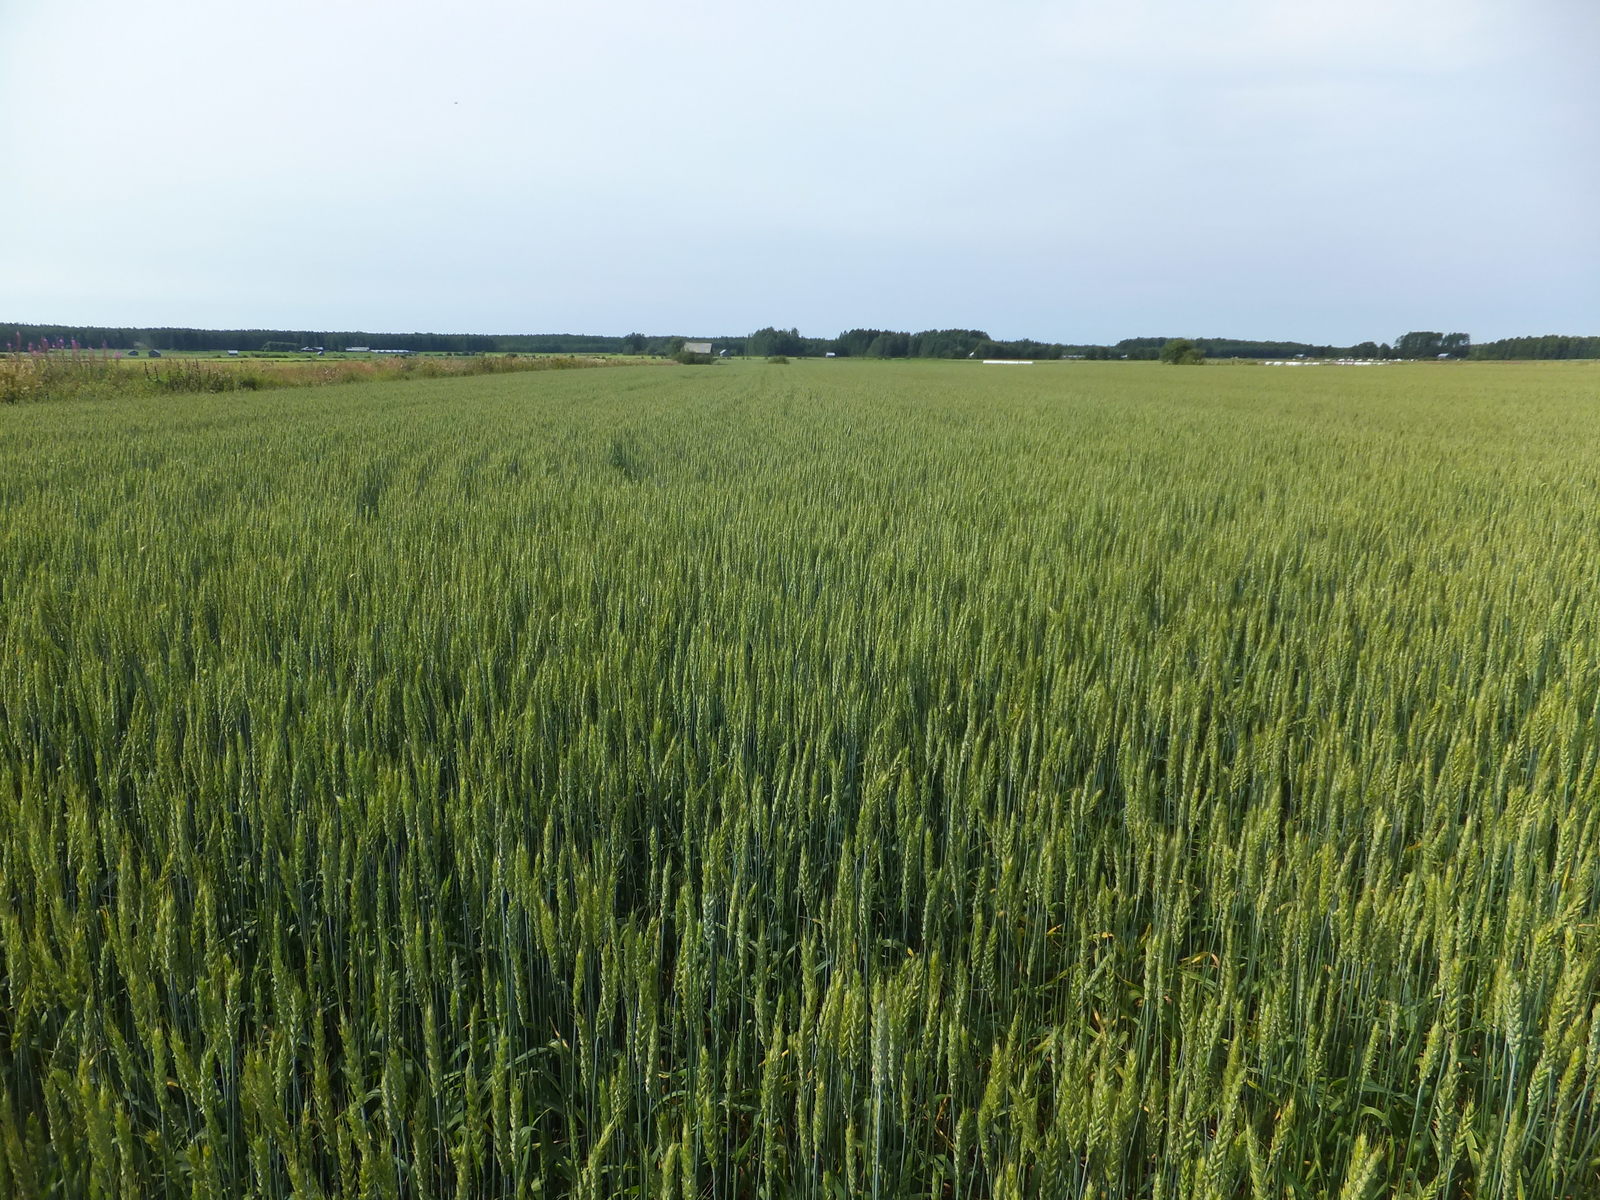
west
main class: Cropland
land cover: Common wheat
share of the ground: > 75 %
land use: Agriculture (excluding fallow land and kitchen gardens)
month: August
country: FI
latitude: 63.2170
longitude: 22.8043
